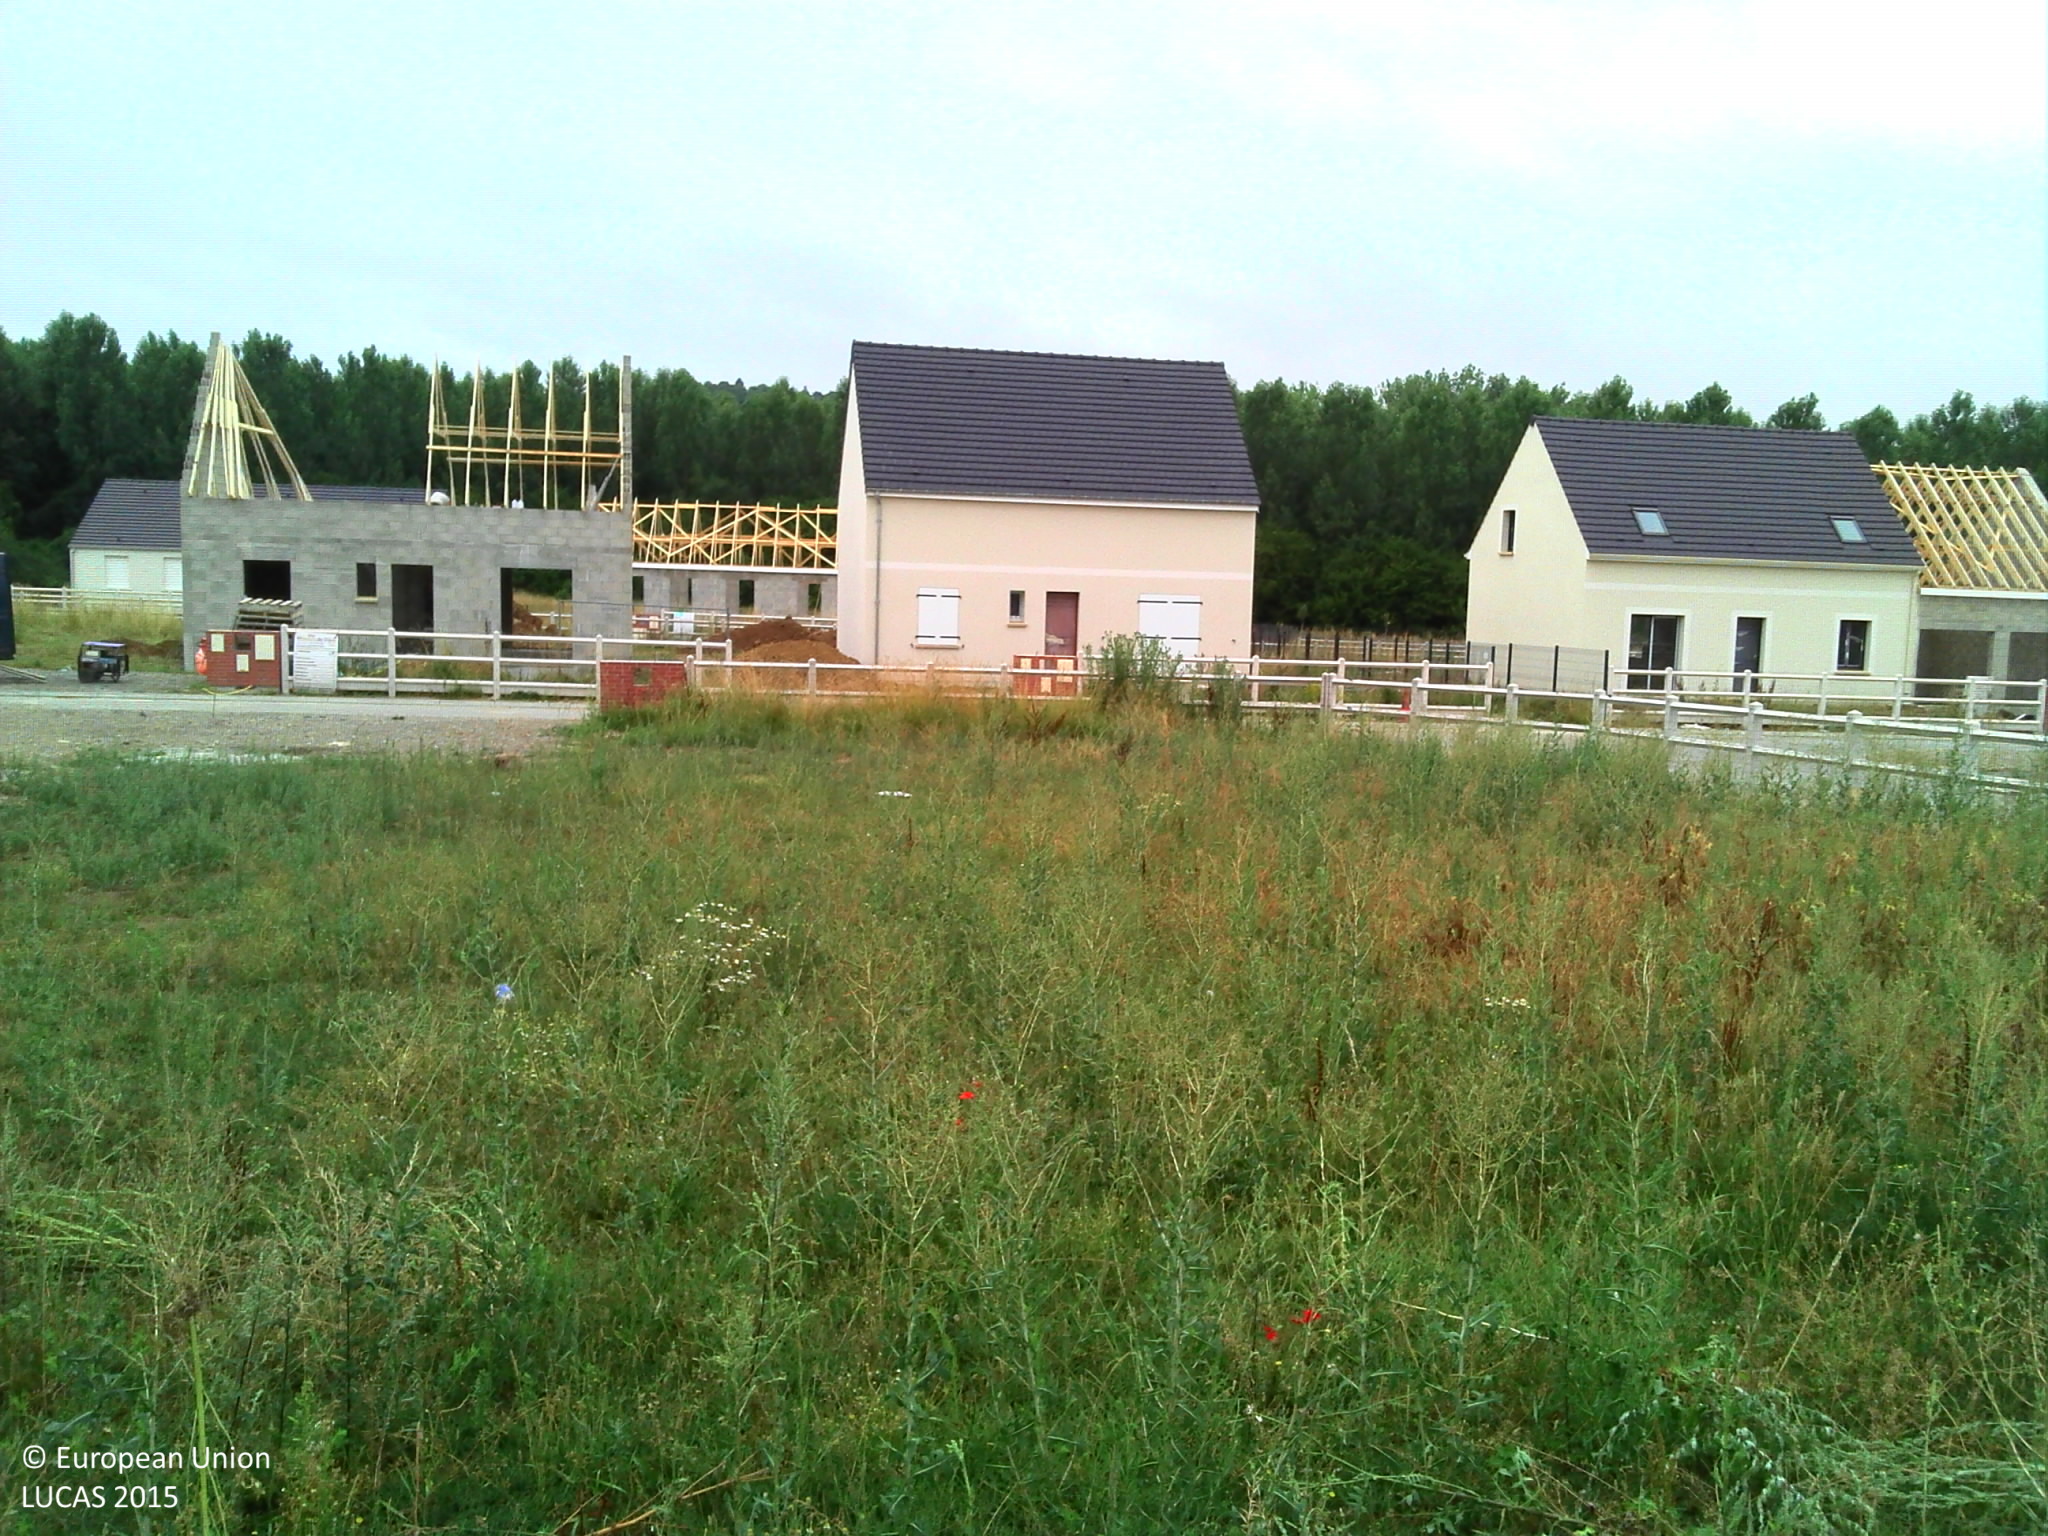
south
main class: Grassland
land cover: Grassland with sparse tree/shrub cover
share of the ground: > 75 %
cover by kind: herbaceous plants 95 %, broadleaved forest trees 5 %
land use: Residential
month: July
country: FR
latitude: 49.3901
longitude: 2.4241
